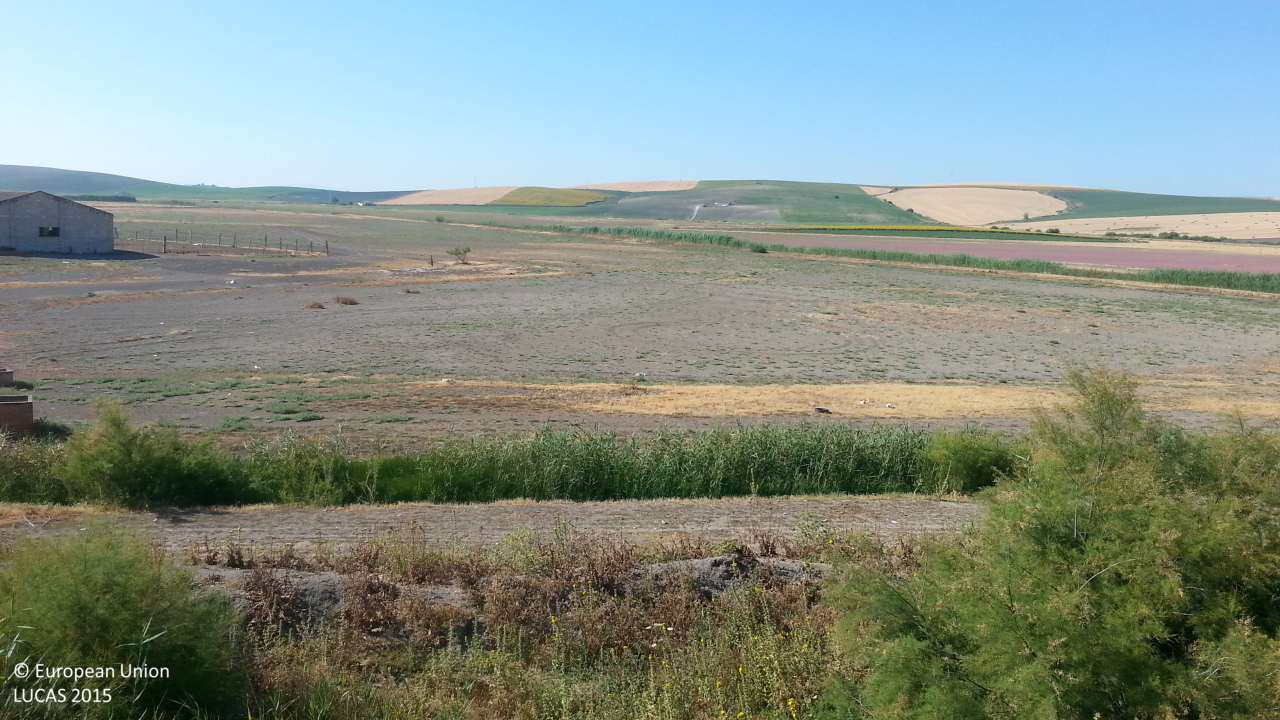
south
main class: Shrubland
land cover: Shrubland without tree cover
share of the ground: 50 - 75 %
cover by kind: shrubs 50 %, unconsolidated bare surface 45 %, herbaceous plants 5 %
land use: Agriculture (excluding fallow land and kitchen gardens)
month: June
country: ES
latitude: 36.9948
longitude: -5.9827
